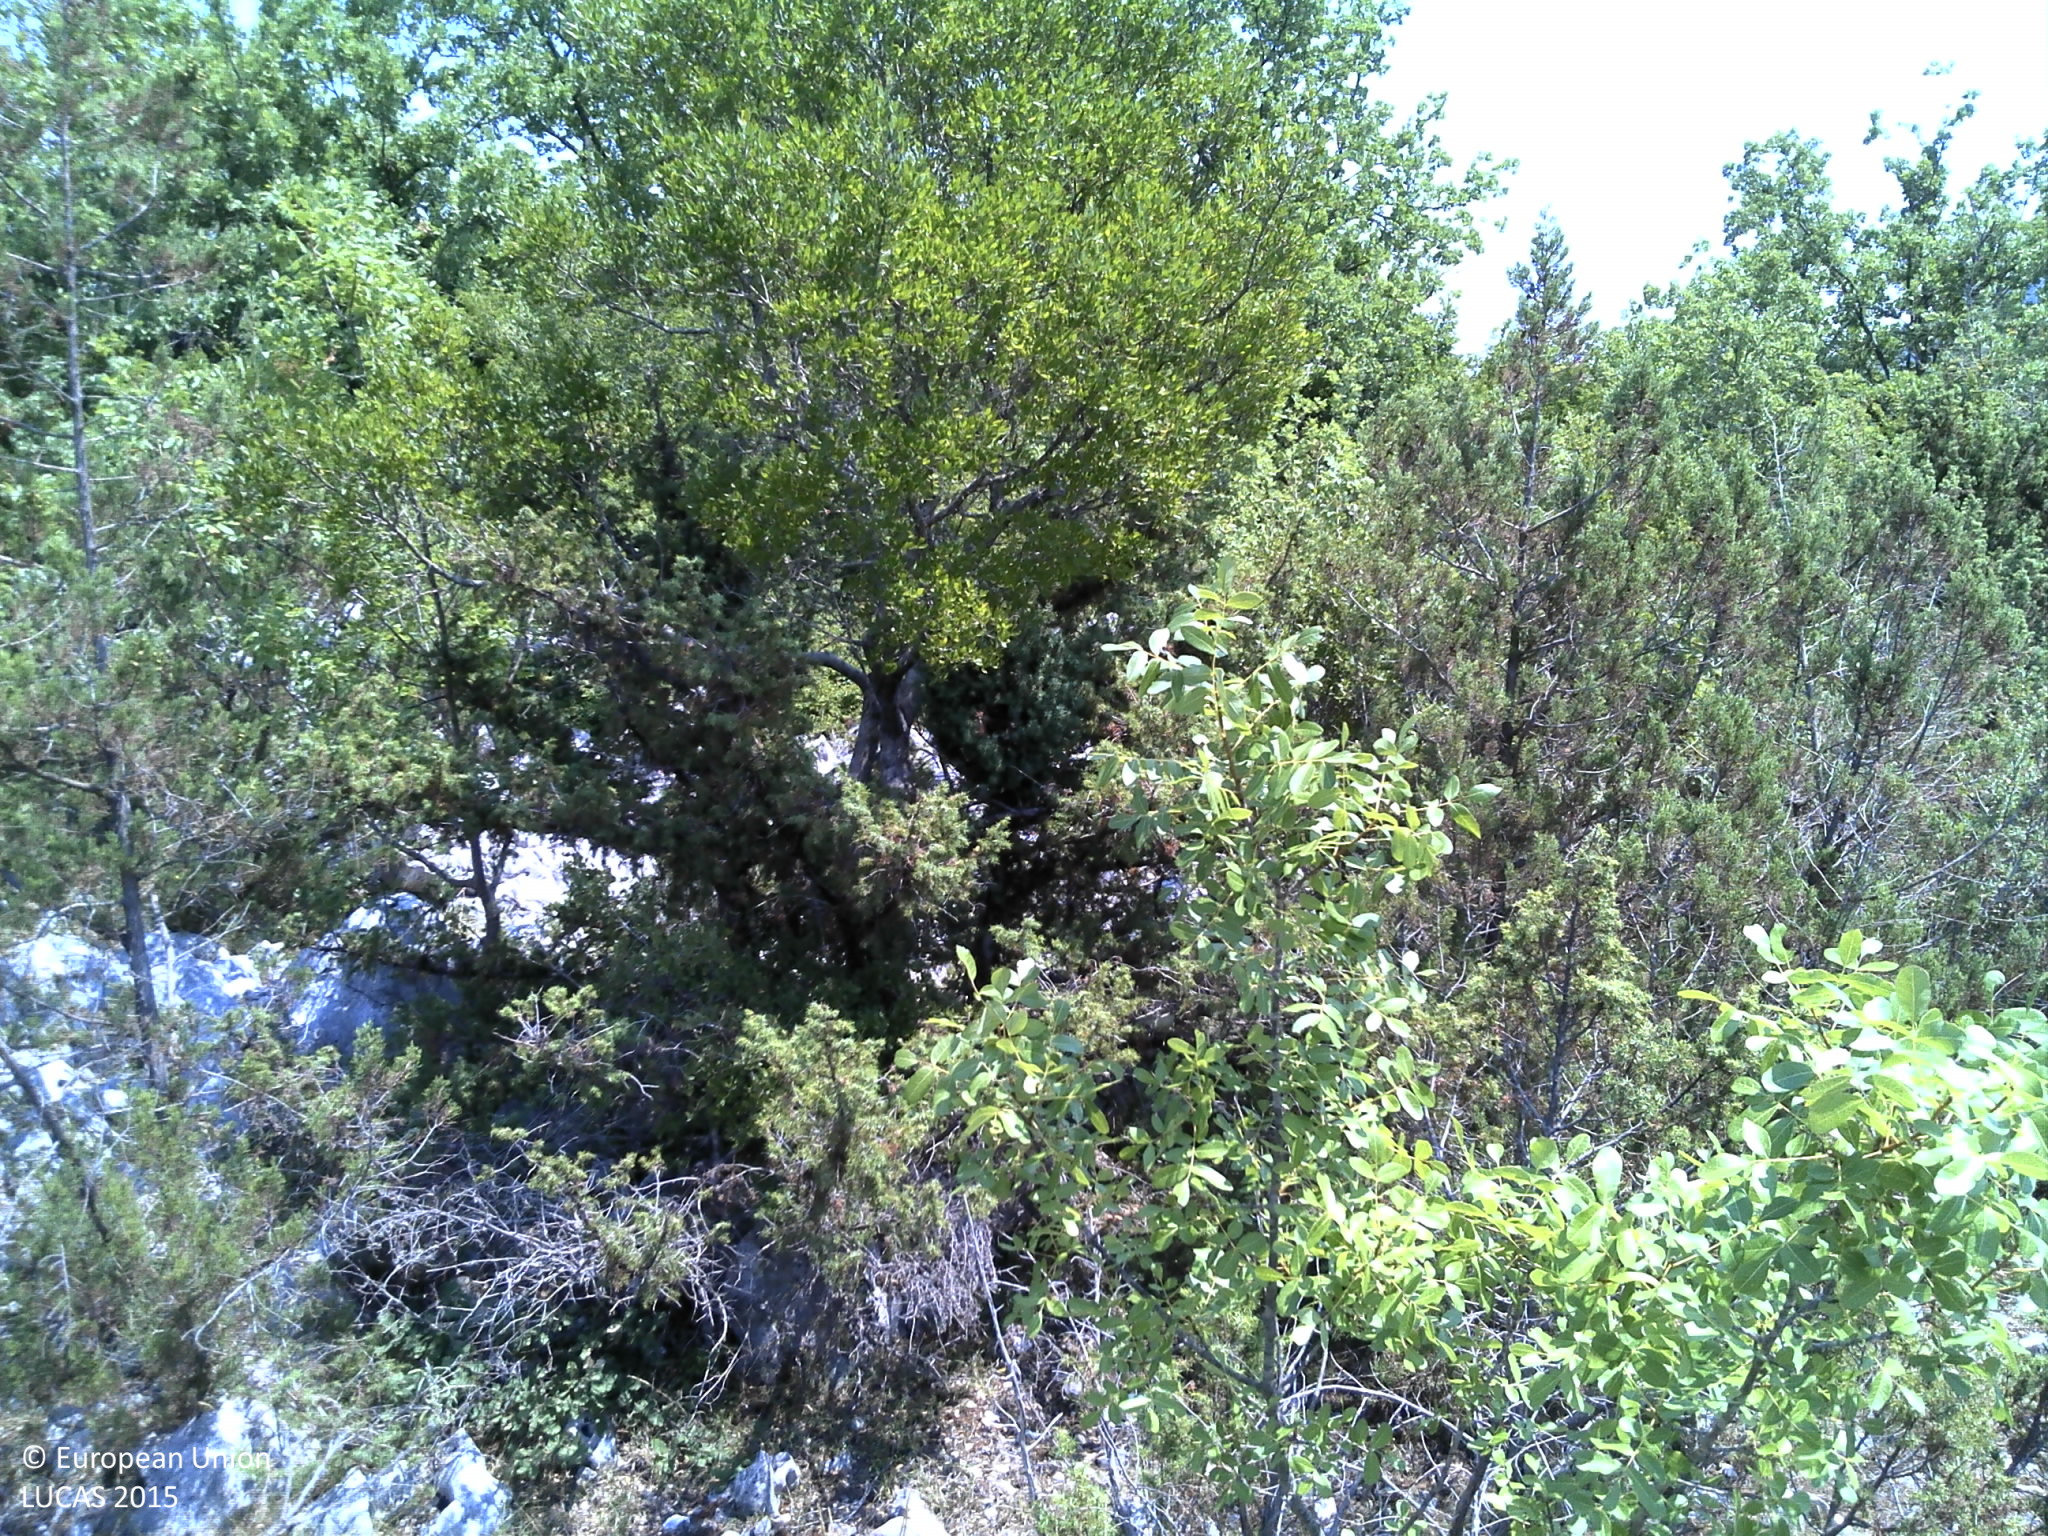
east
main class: Woodland
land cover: Broadleaved woodland
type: thermophilous deciduous forest
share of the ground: 25 - 50 %
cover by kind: broadleaved forest trees 35 %, shrubs 30 %, unconsolidated bare surface 20 %, consolidated bare surface 10 %, coniferous forest trees 5 %
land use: Semi-natural and natural areas not in use
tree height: > 5 m
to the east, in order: Broadleaved woodland; Dry stone walls; Shrubland with sparse tree cover; Dry stone walls; Broadleaved woodland; Shrubland with sparse tree cover
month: July
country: HR
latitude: 42.9068
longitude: 17.6700
